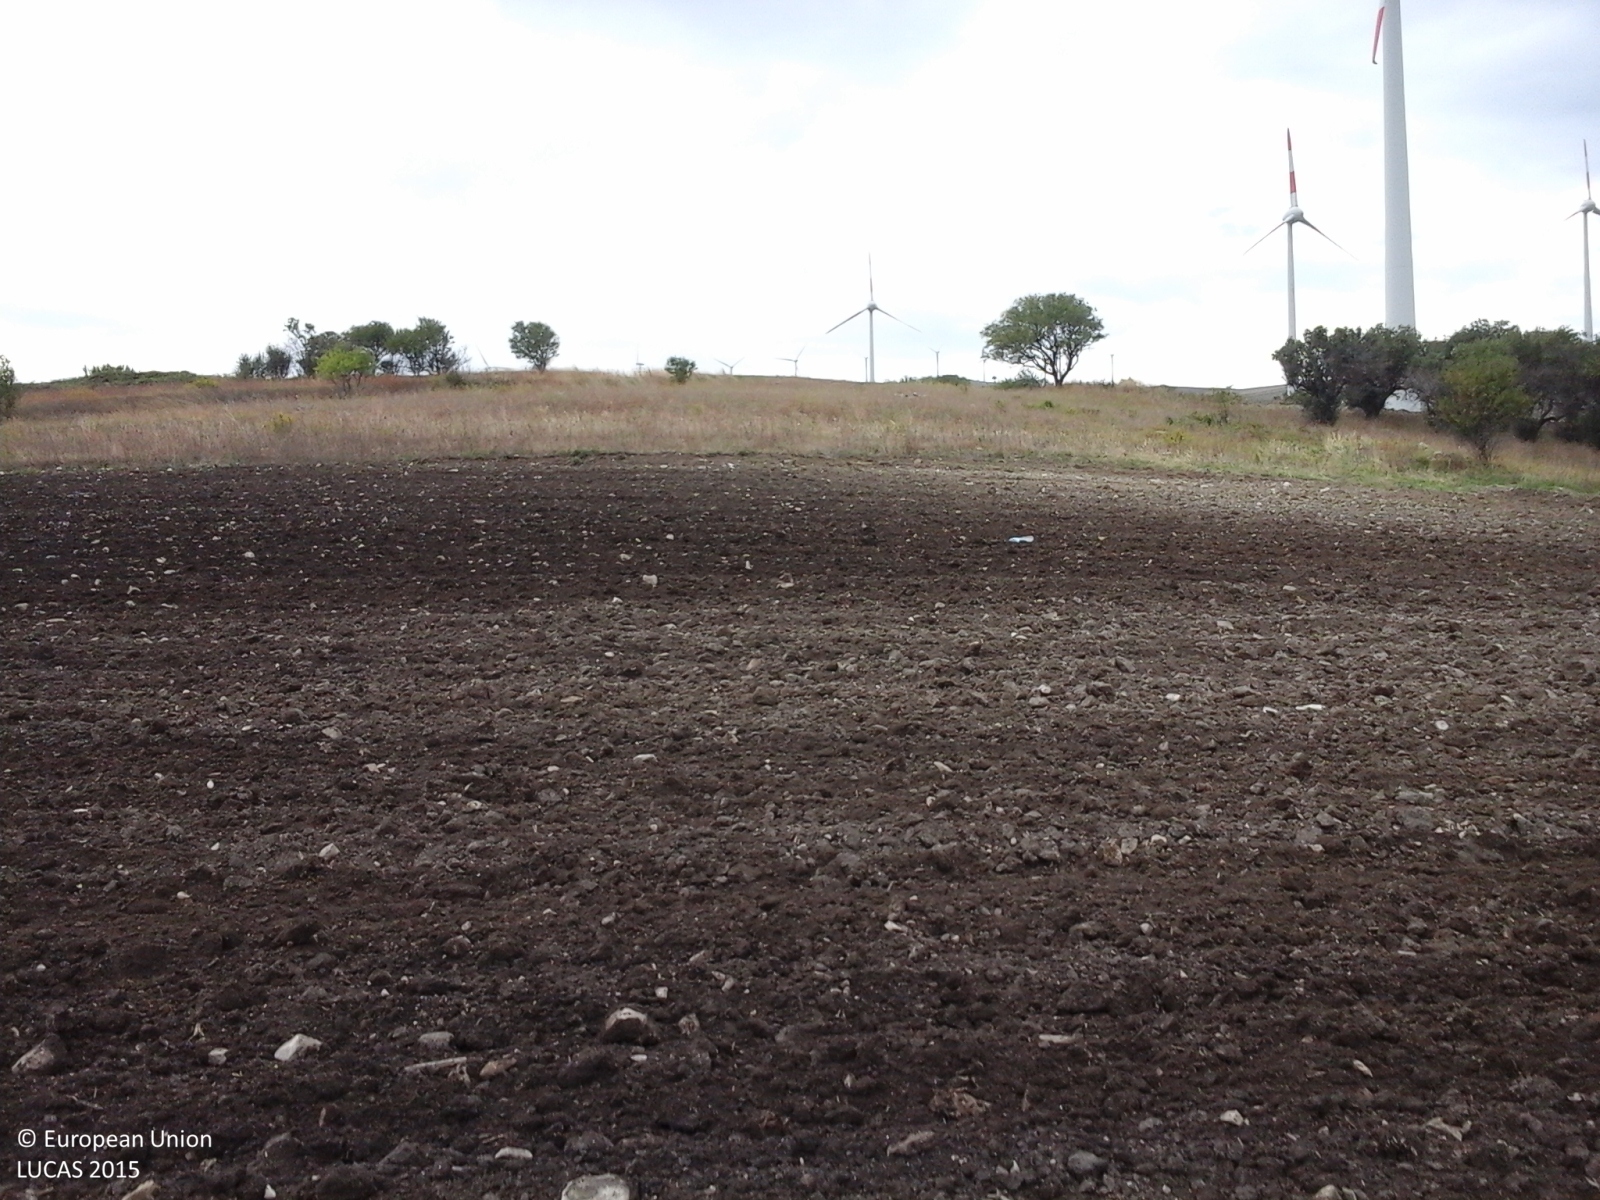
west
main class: Cropland
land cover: Durum wheat
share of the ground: > 75 %
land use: Agriculture (excluding fallow land and kitchen gardens)
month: October
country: IT
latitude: 41.5636
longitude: 15.1511
